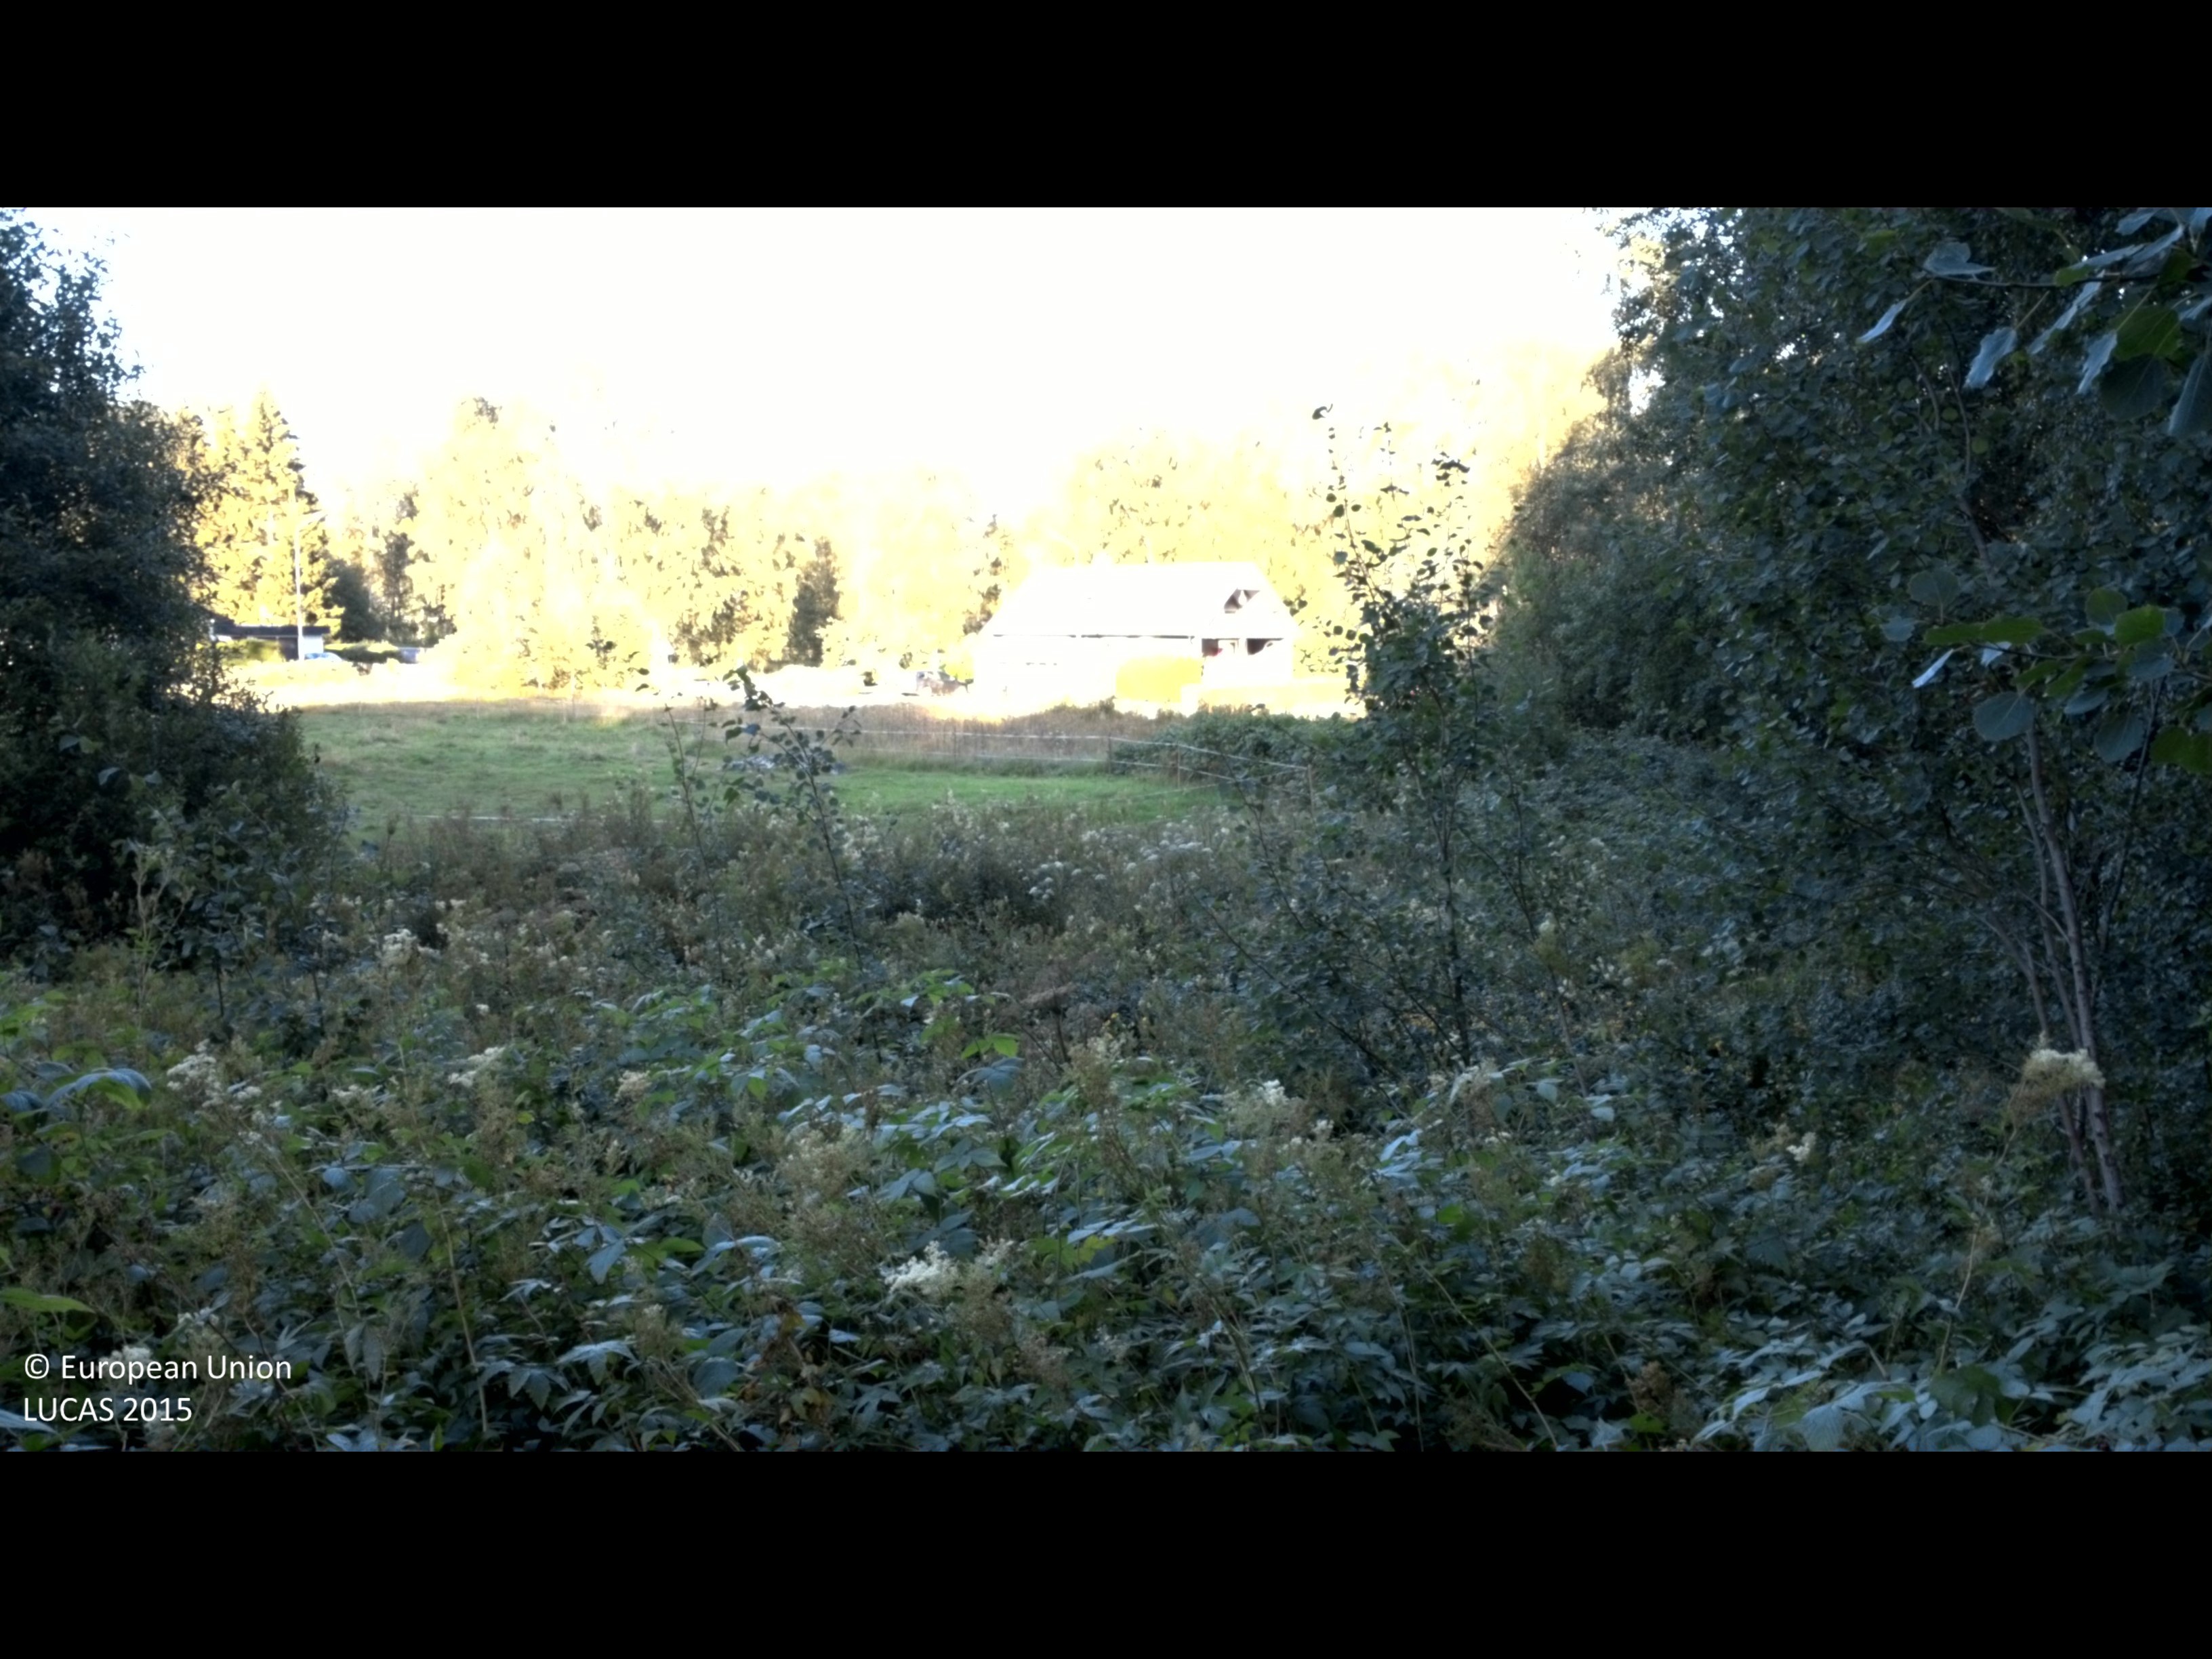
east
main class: Woodland
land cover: Broadleaved woodland
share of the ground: 50 - 75 %
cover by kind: broadleaved forest trees 60 %, shrubs 40 %
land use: Semi-natural and natural areas not in use
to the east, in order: Broadleaved woodland; Fences; Grassland without tree/shrub cover; Fences; Shrubland without tree cover; Grassland without tree/shrub cover; Artificial constructions in urban areas; Broadleaved woodland; Dry stone walls; Grassland without tree/shrub cover; Artificial constructions in urban areas
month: August
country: SE
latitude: 57.0106
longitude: 13.2404
